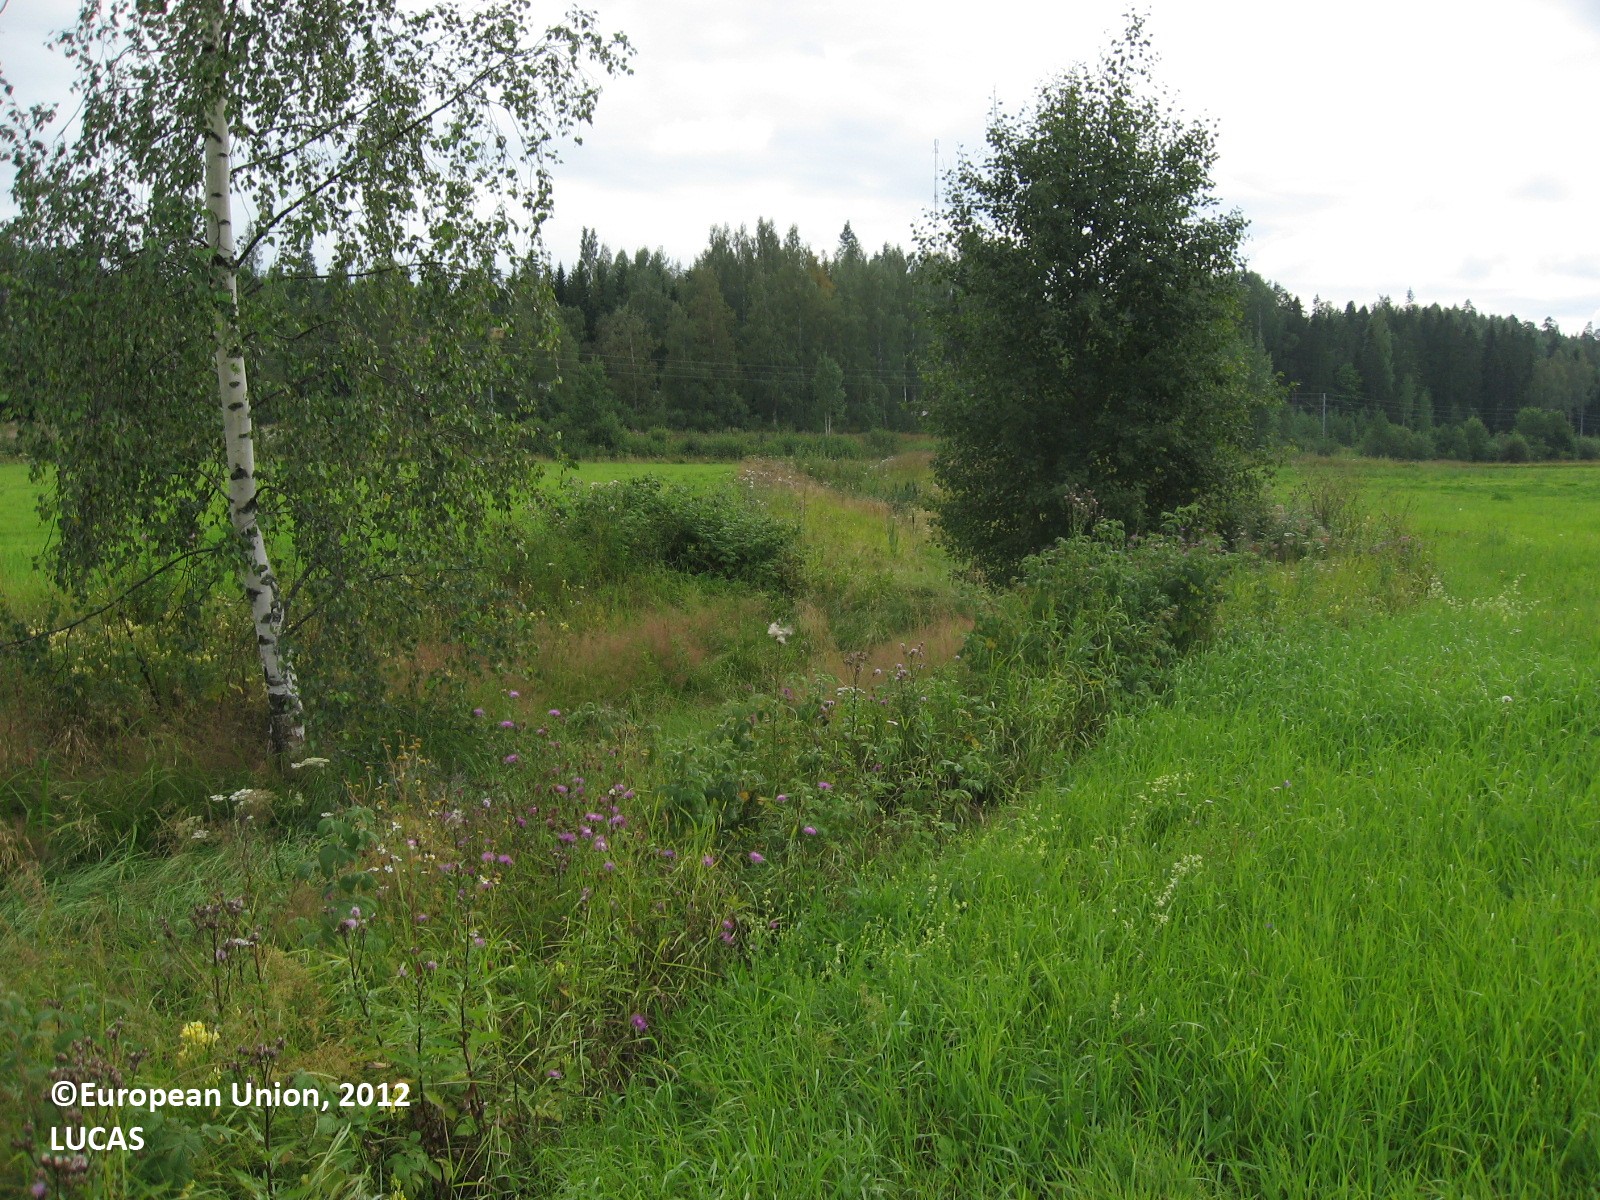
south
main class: Cropland
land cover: Temporary grasslands
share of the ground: > 75 %
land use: Agriculture (excluding fallow land and kitchen gardens)
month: August
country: FI
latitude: 60.3858
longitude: 25.3102
